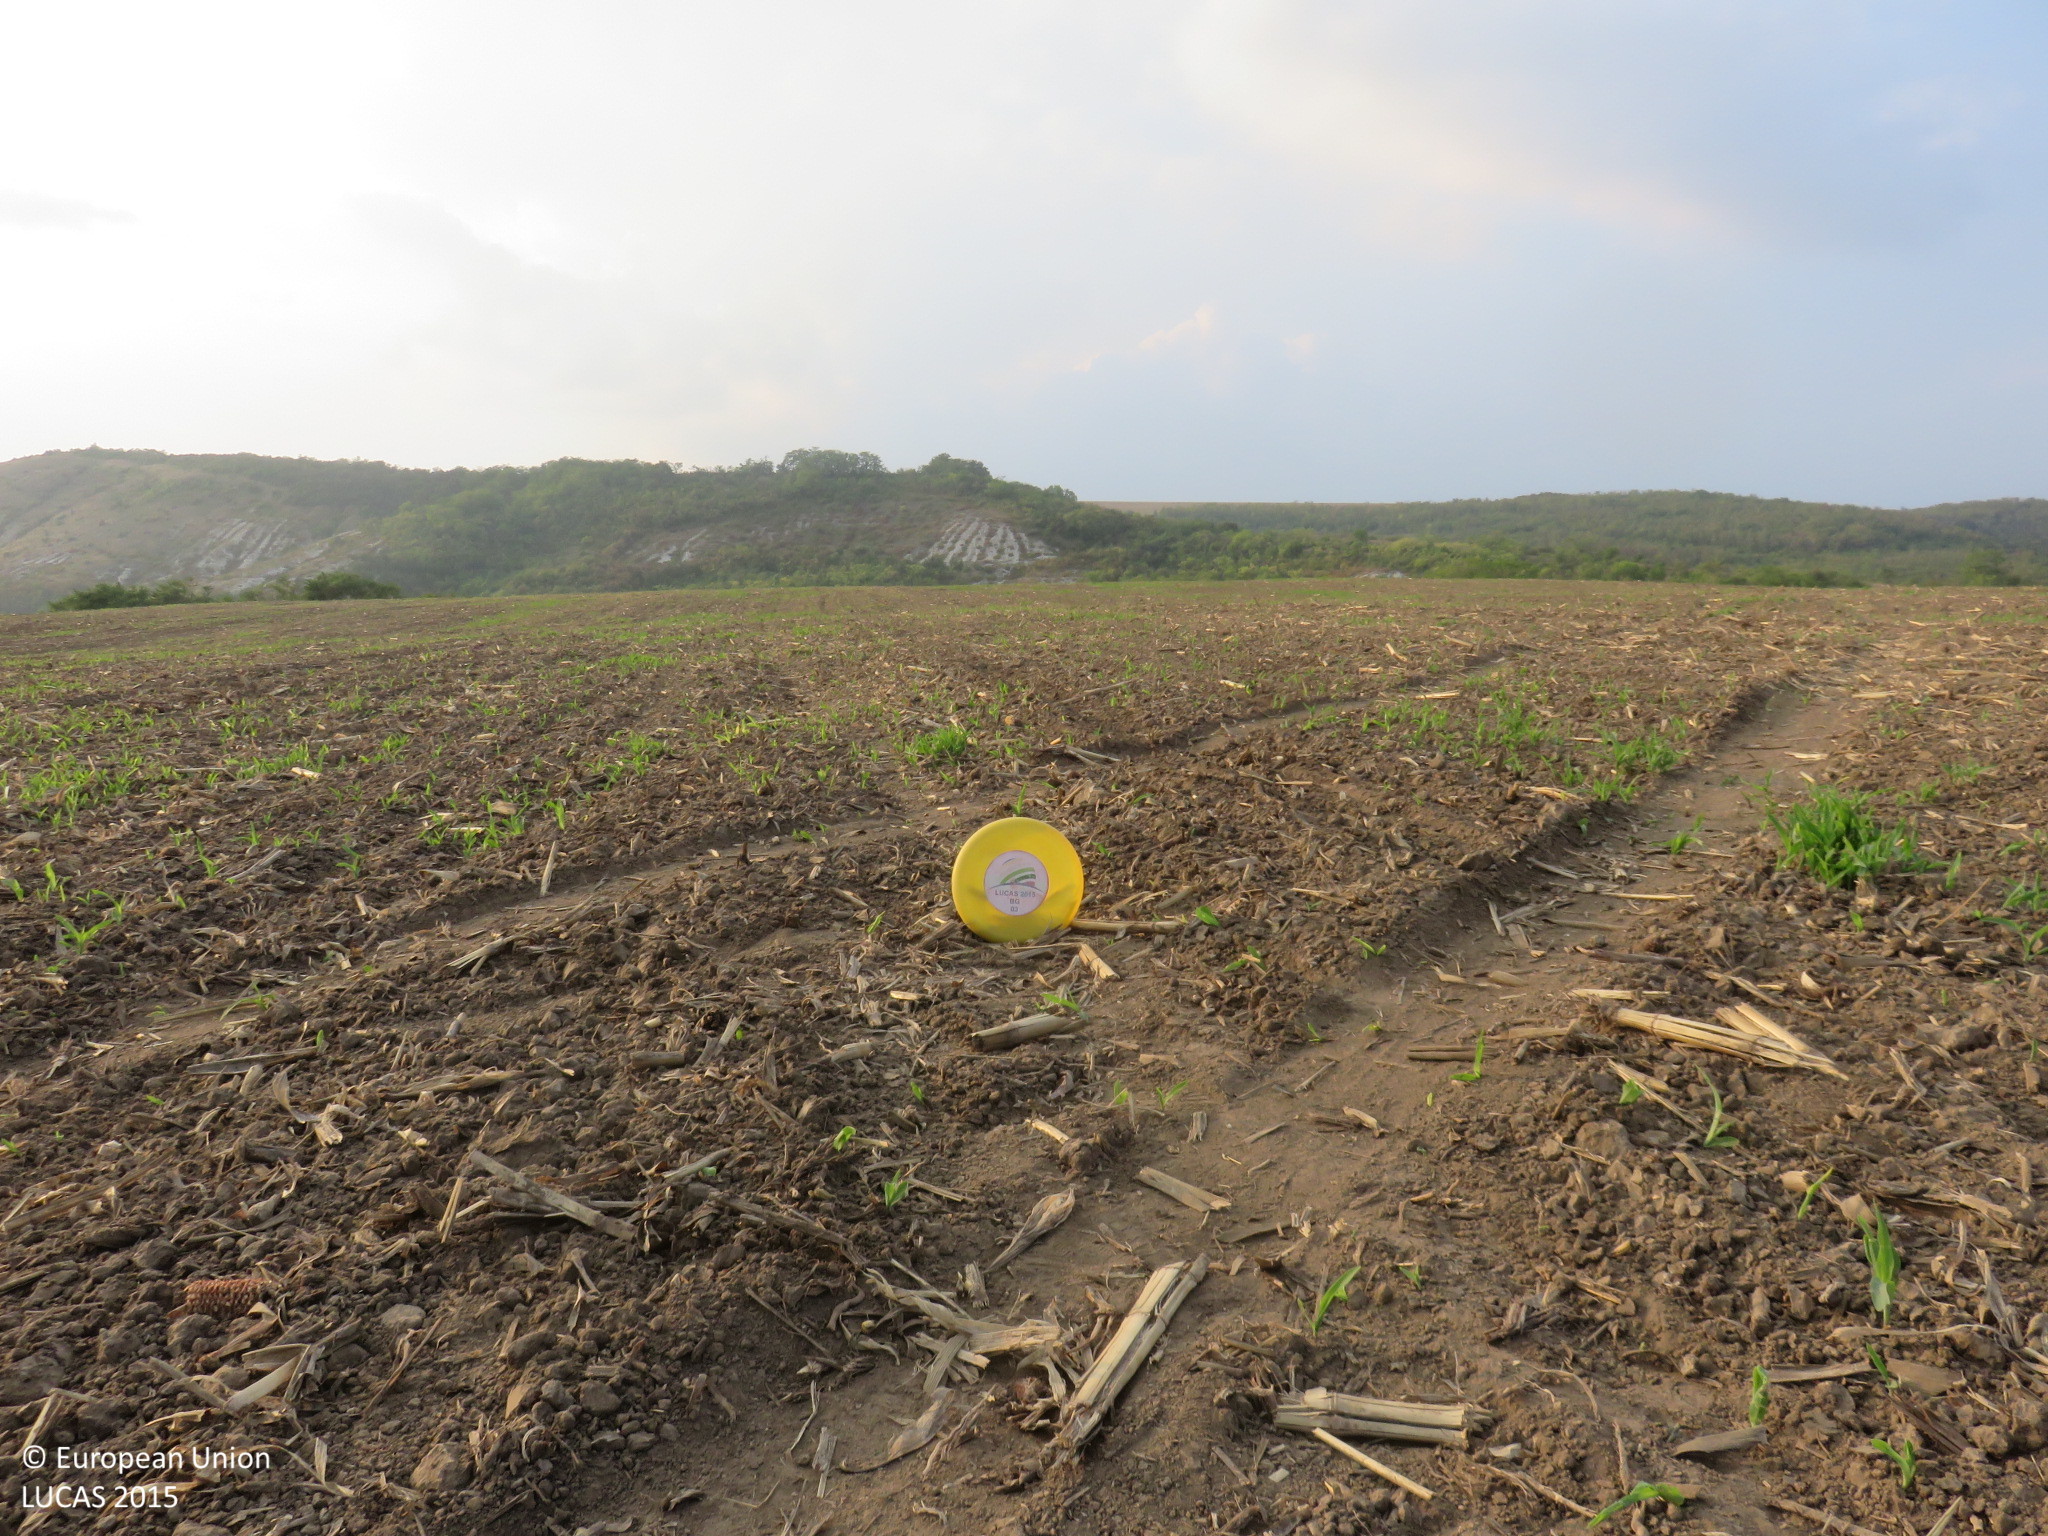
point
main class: Cropland
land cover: Maize
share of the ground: < 10 %
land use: Agriculture (excluding fallow land and kitchen gardens)
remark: Harvested field
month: September
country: BG
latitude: 43.5693
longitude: 24.9664
